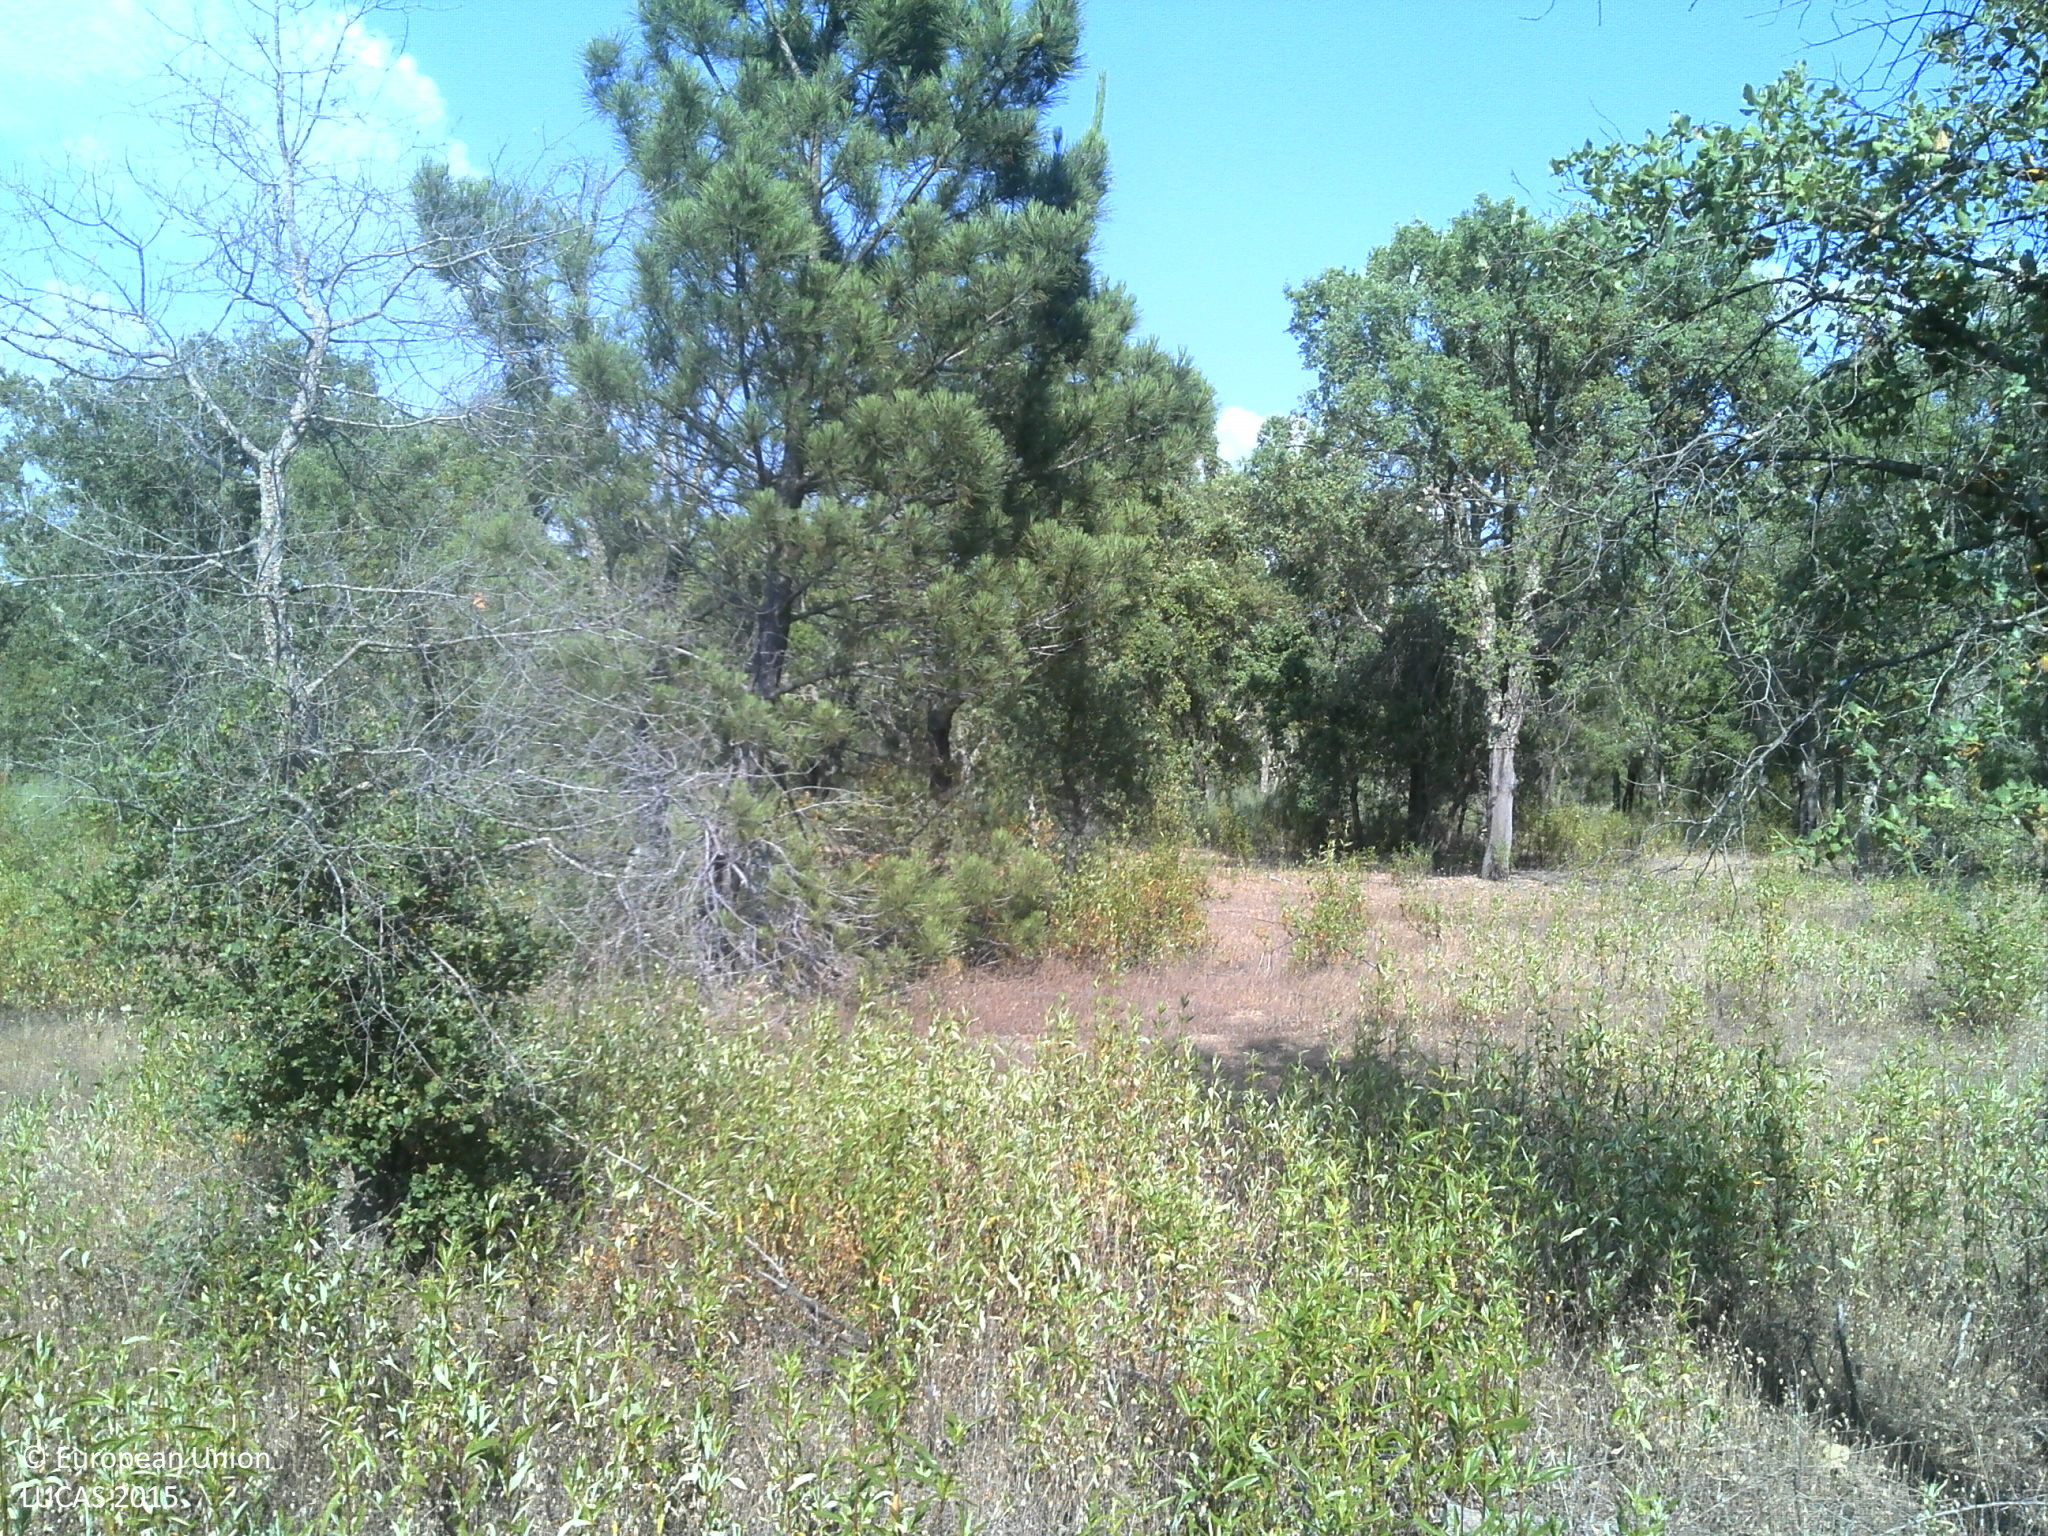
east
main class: Woodland
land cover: Broadleaved woodland
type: broadleaved evergreen forest
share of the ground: 10 - 25 %
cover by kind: shrubs 40 %, broadleaved forest trees 25 %, herbaceous plants 20 %, unconsolidated bare surface 15 %
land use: Forestry
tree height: > 5 m
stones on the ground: 10 - 25 %
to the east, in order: Broadleaved woodland; Tracks; Broadleaved woodland
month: June
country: PT
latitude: 39.4005
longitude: -7.9985
